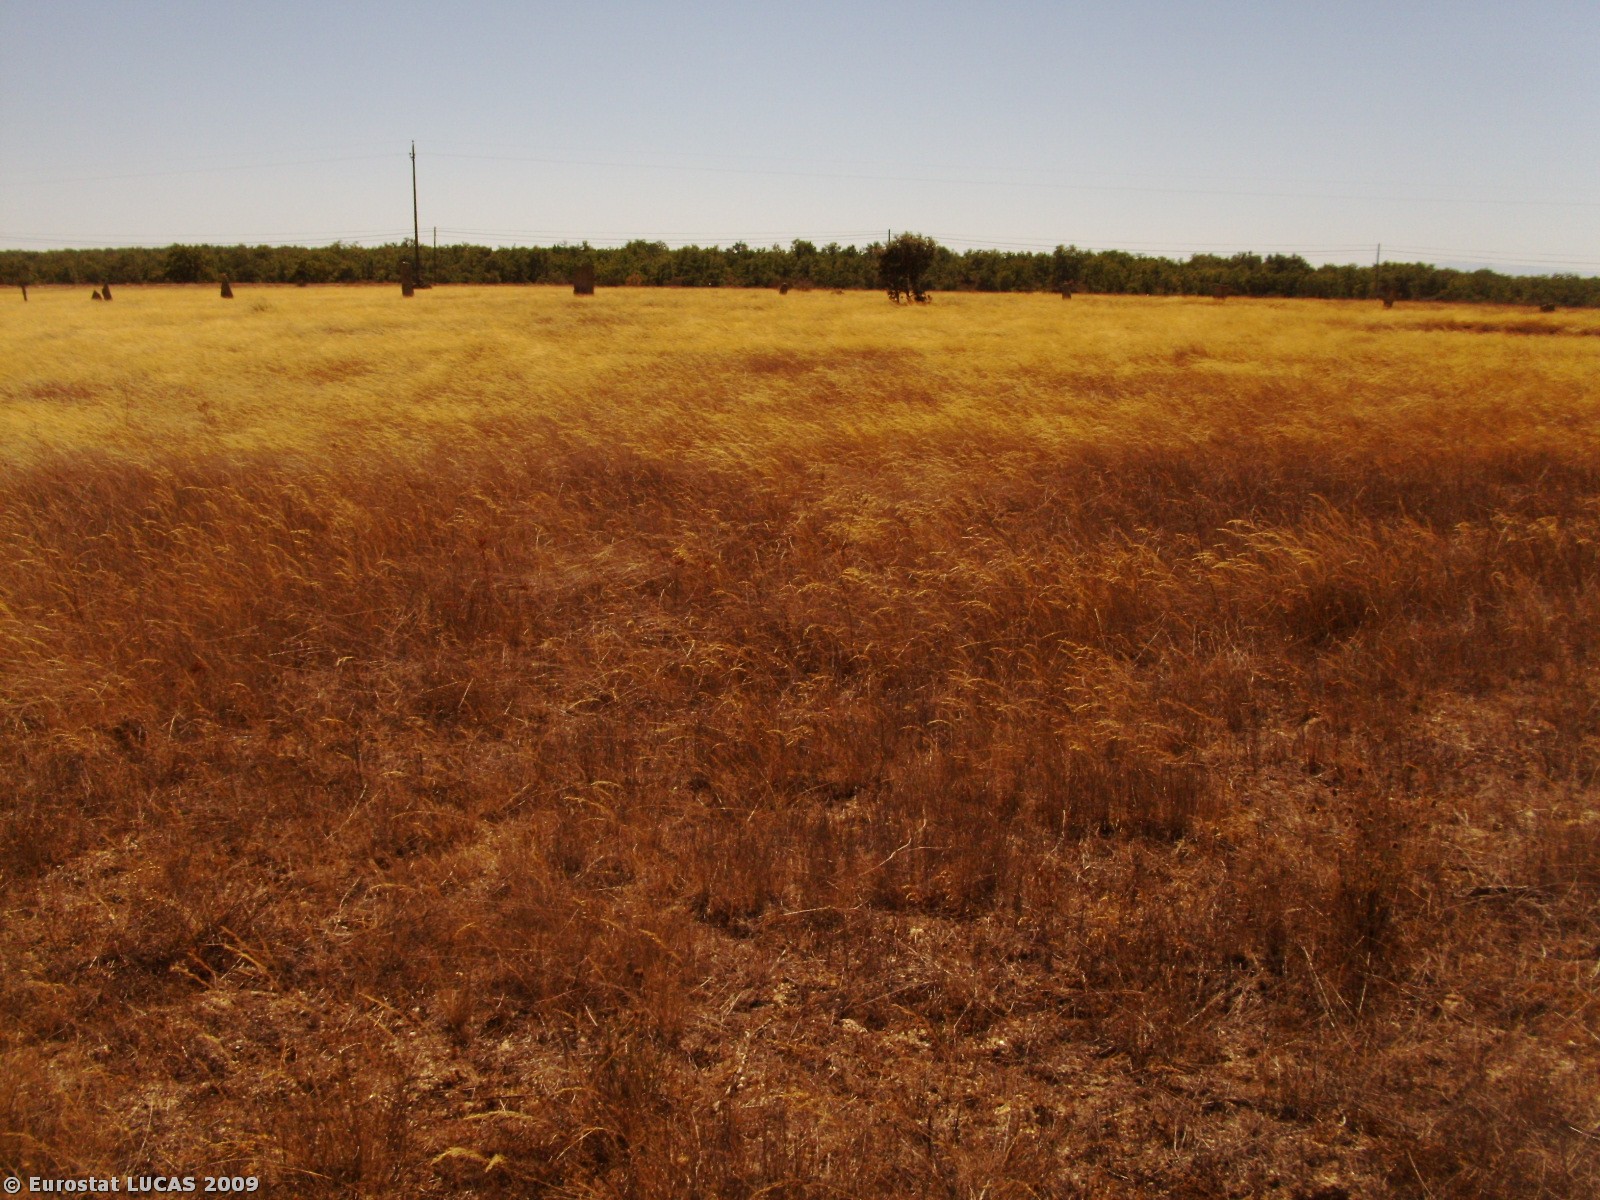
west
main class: Woodland
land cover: Broadleaved woodland
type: broadleaved evergreen forest
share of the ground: 25 - 50 %
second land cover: Spontaneously vegetated surfaces
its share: 50 - 75 %
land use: Forestry
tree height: > 5 m
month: July
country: PT
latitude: 40.5310
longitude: -6.8474
